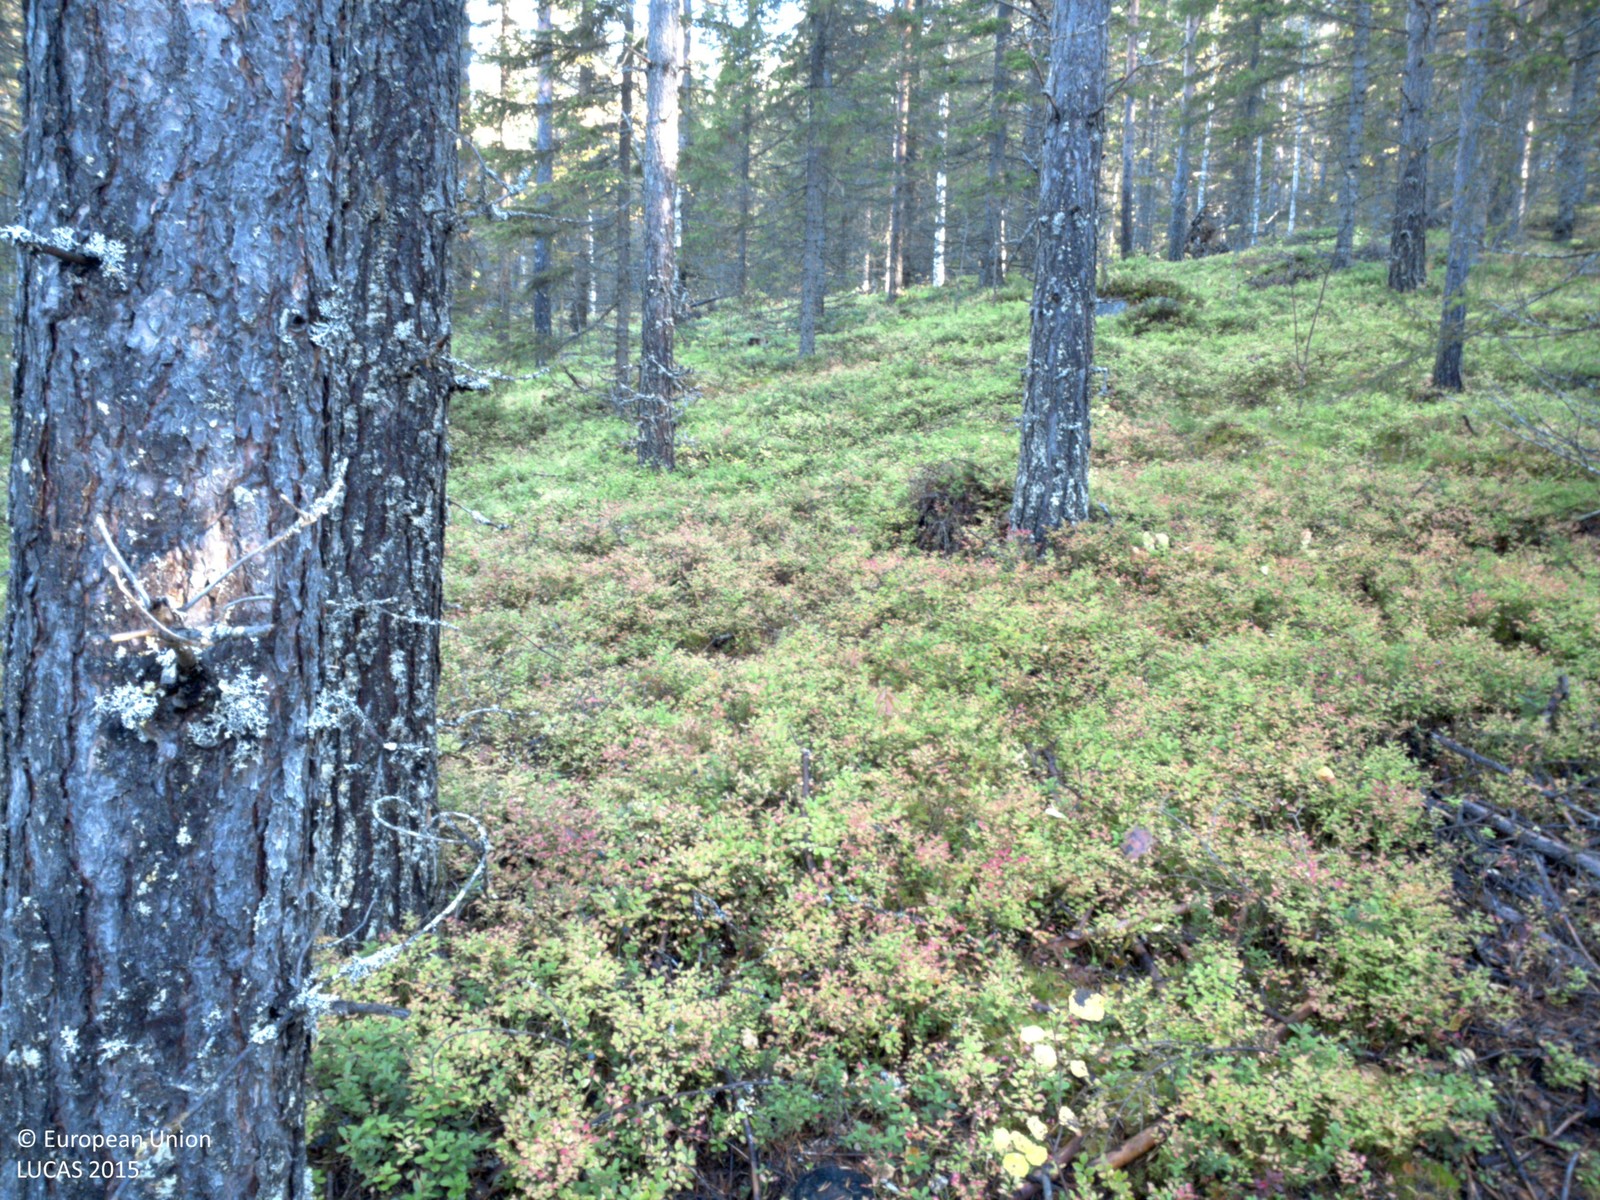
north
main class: Woodland
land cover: Other coniferous woodland
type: boreal forest
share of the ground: > 75 %
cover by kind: coniferous forest trees 75 %, shrubs 15 %, lichens and mosses 10 %
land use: Forestry
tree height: > 5 m
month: September
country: SE
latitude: 64.8358
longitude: 18.9668
